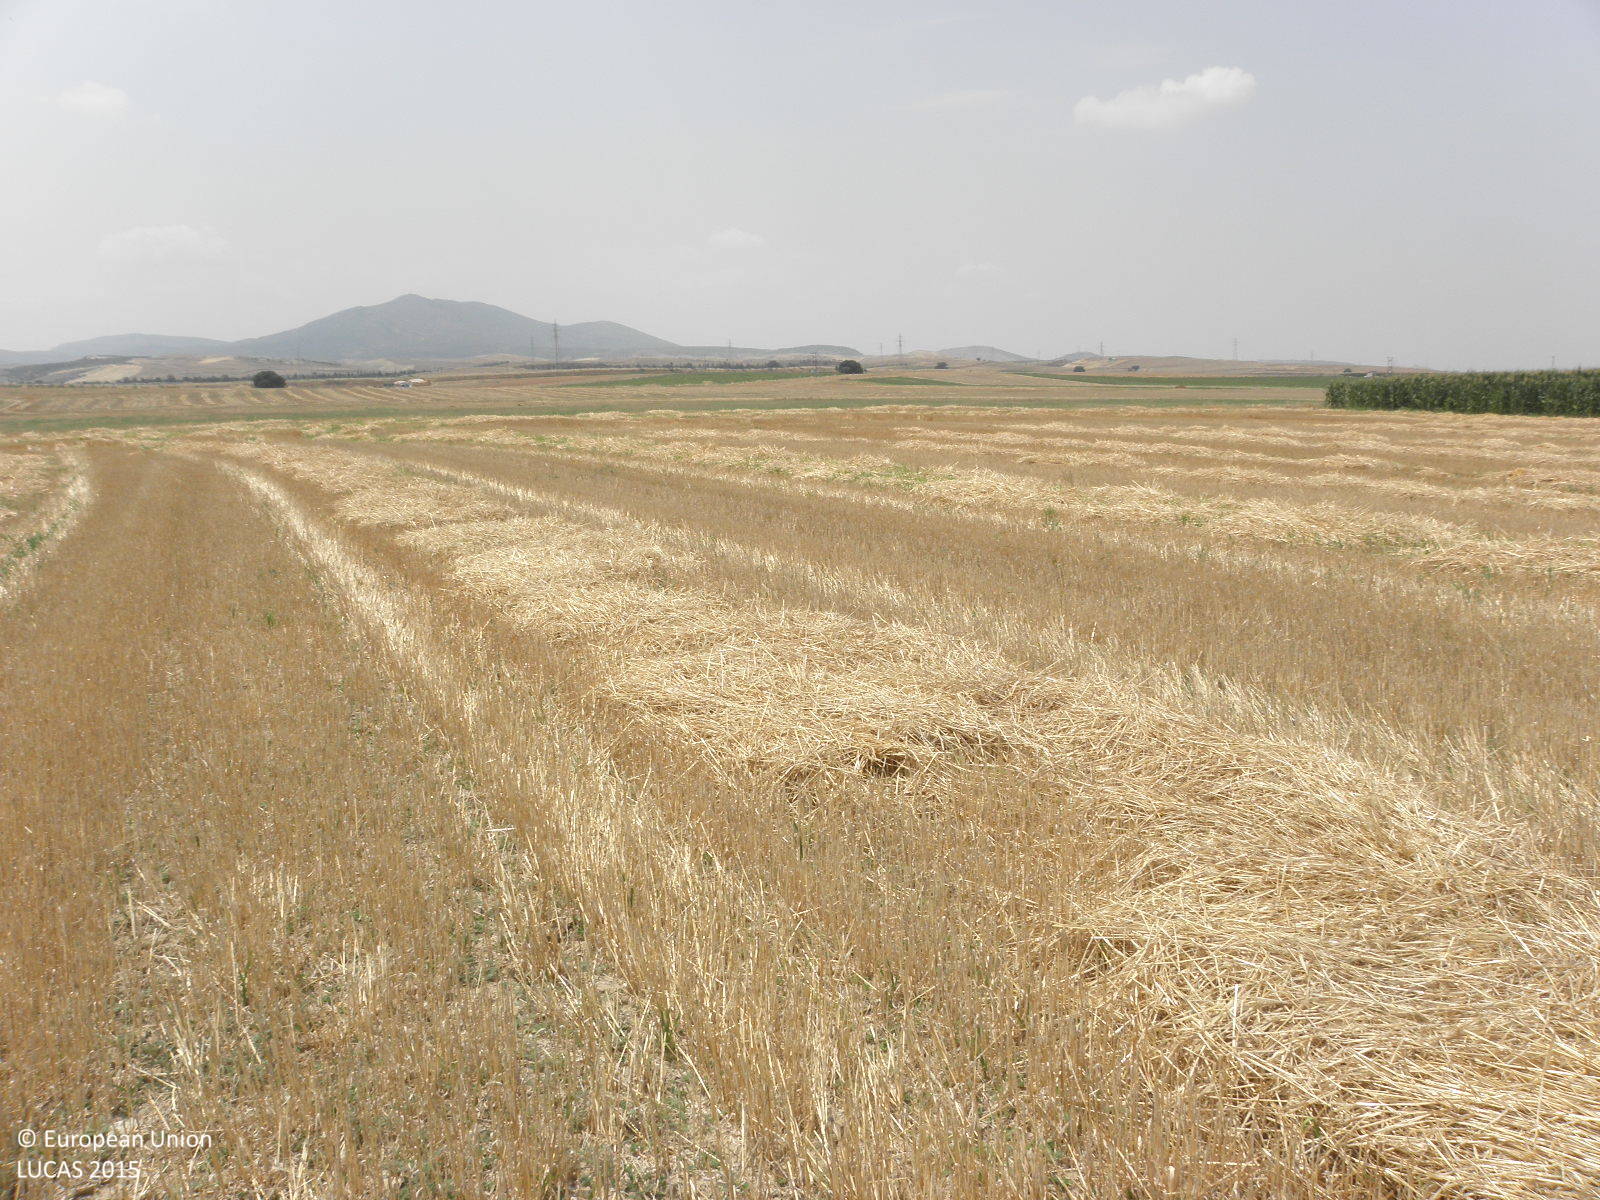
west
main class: Cropland
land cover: Durum wheat
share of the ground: > 75 %
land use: Agriculture (excluding fallow land and kitchen gardens)
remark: Harvested field
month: July
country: GR
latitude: 39.4576
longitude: 22.6929
